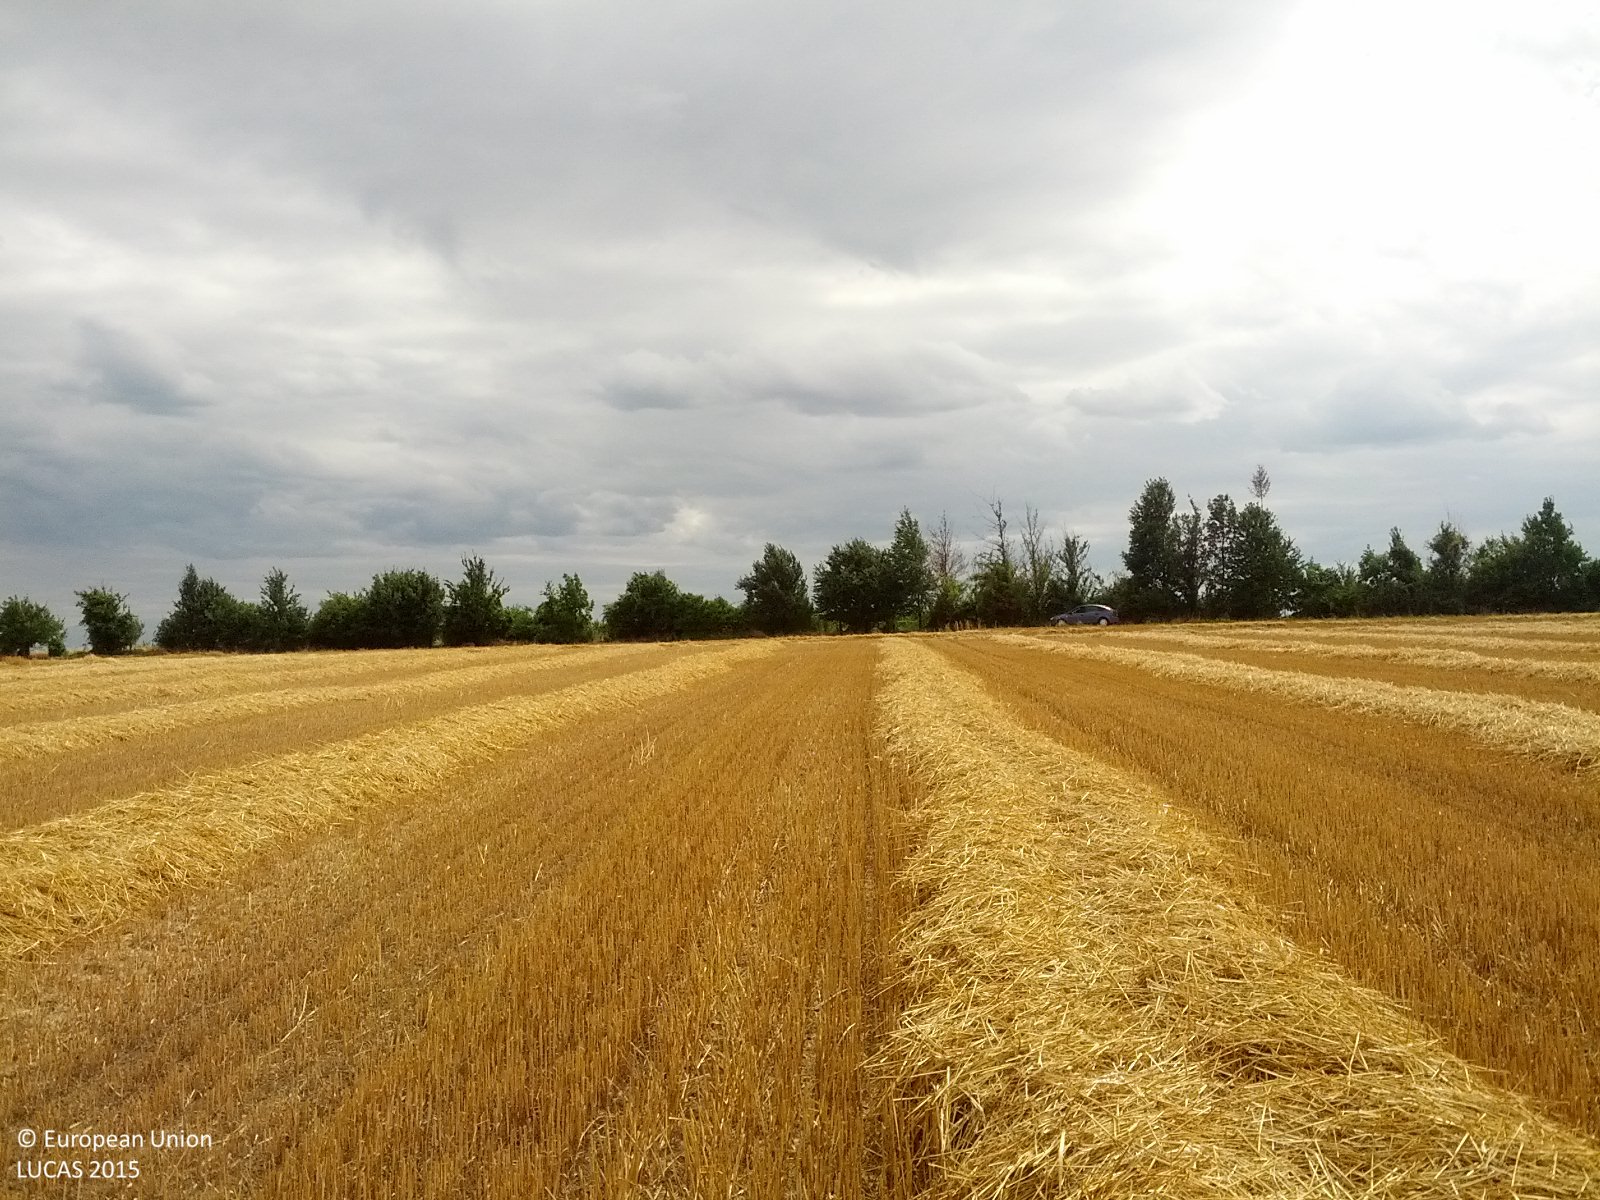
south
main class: Cropland
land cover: Common wheat
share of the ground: > 75 %
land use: Agriculture (excluding fallow land and kitchen gardens)
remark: Harvested field
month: July
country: AT
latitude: 48.5164
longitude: 16.5451
